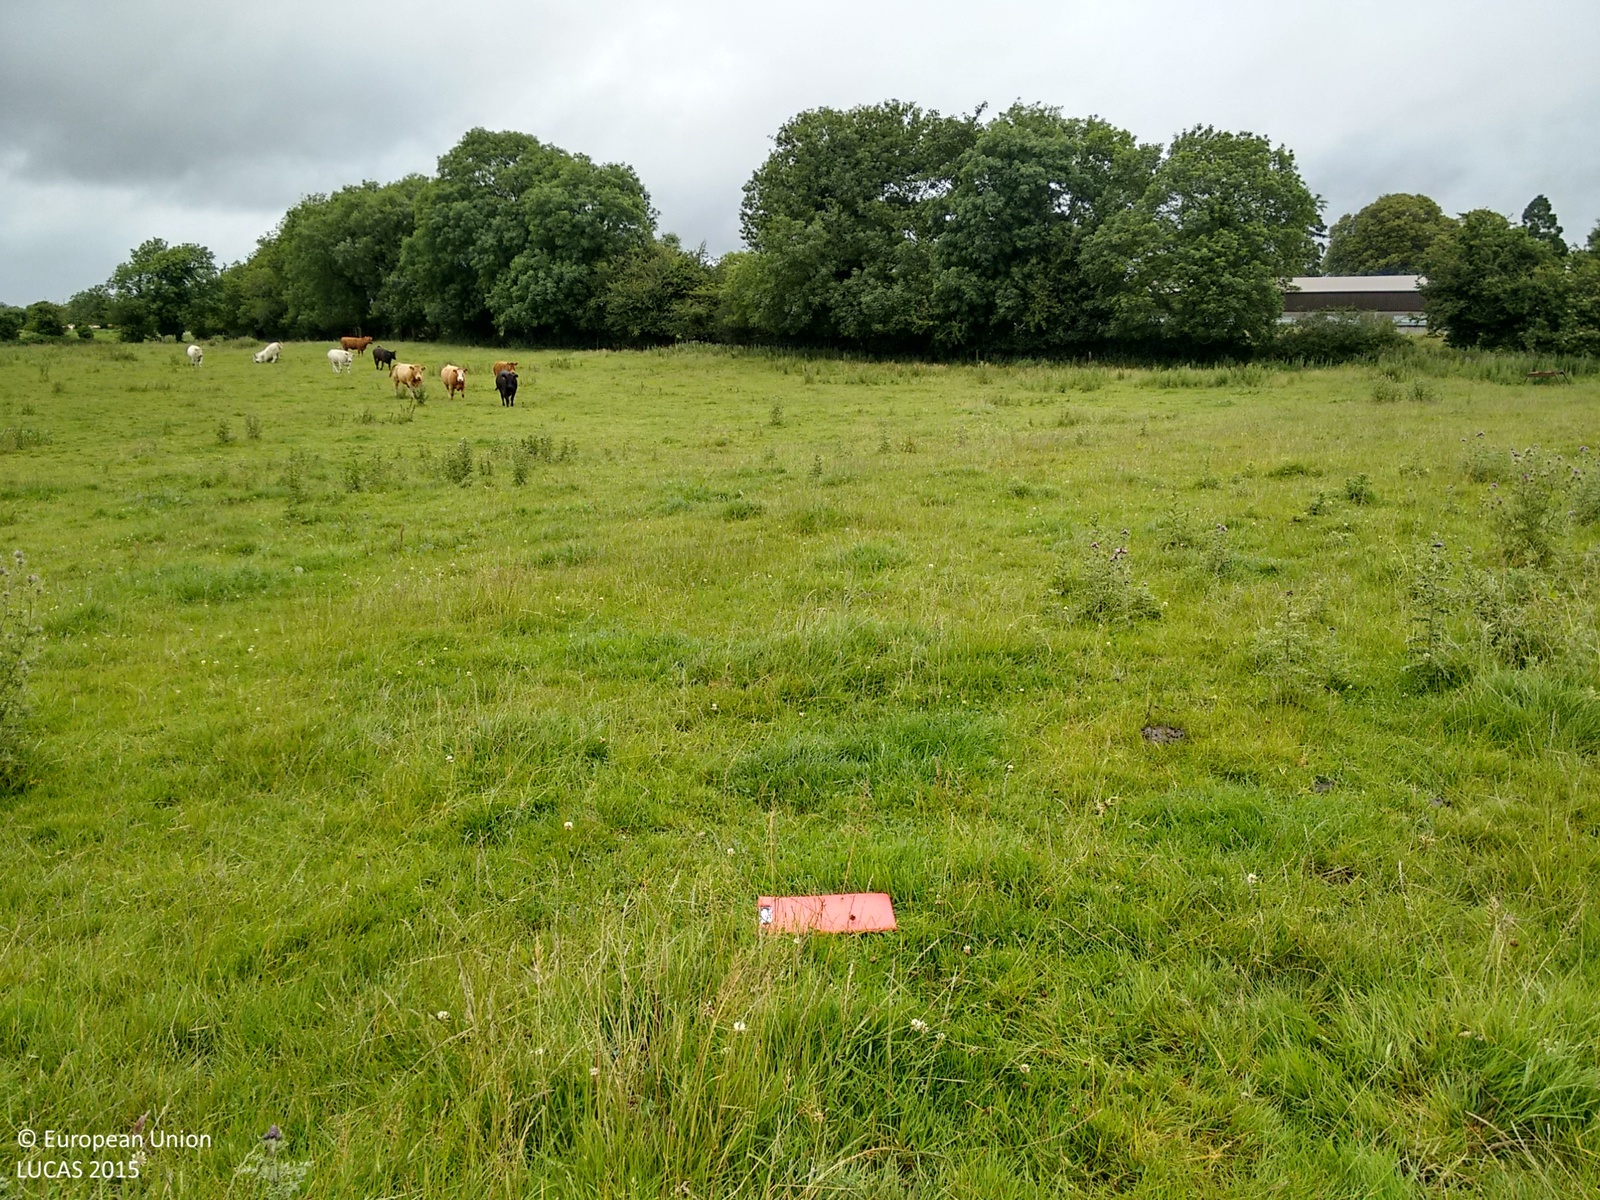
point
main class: Grassland
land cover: Grassland without tree/shrub cover
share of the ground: > 75 %
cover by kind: herbaceous plants 100 %
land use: Agriculture (excluding fallow land and kitchen gardens)
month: July
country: IE
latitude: 53.6543
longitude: -7.7947
